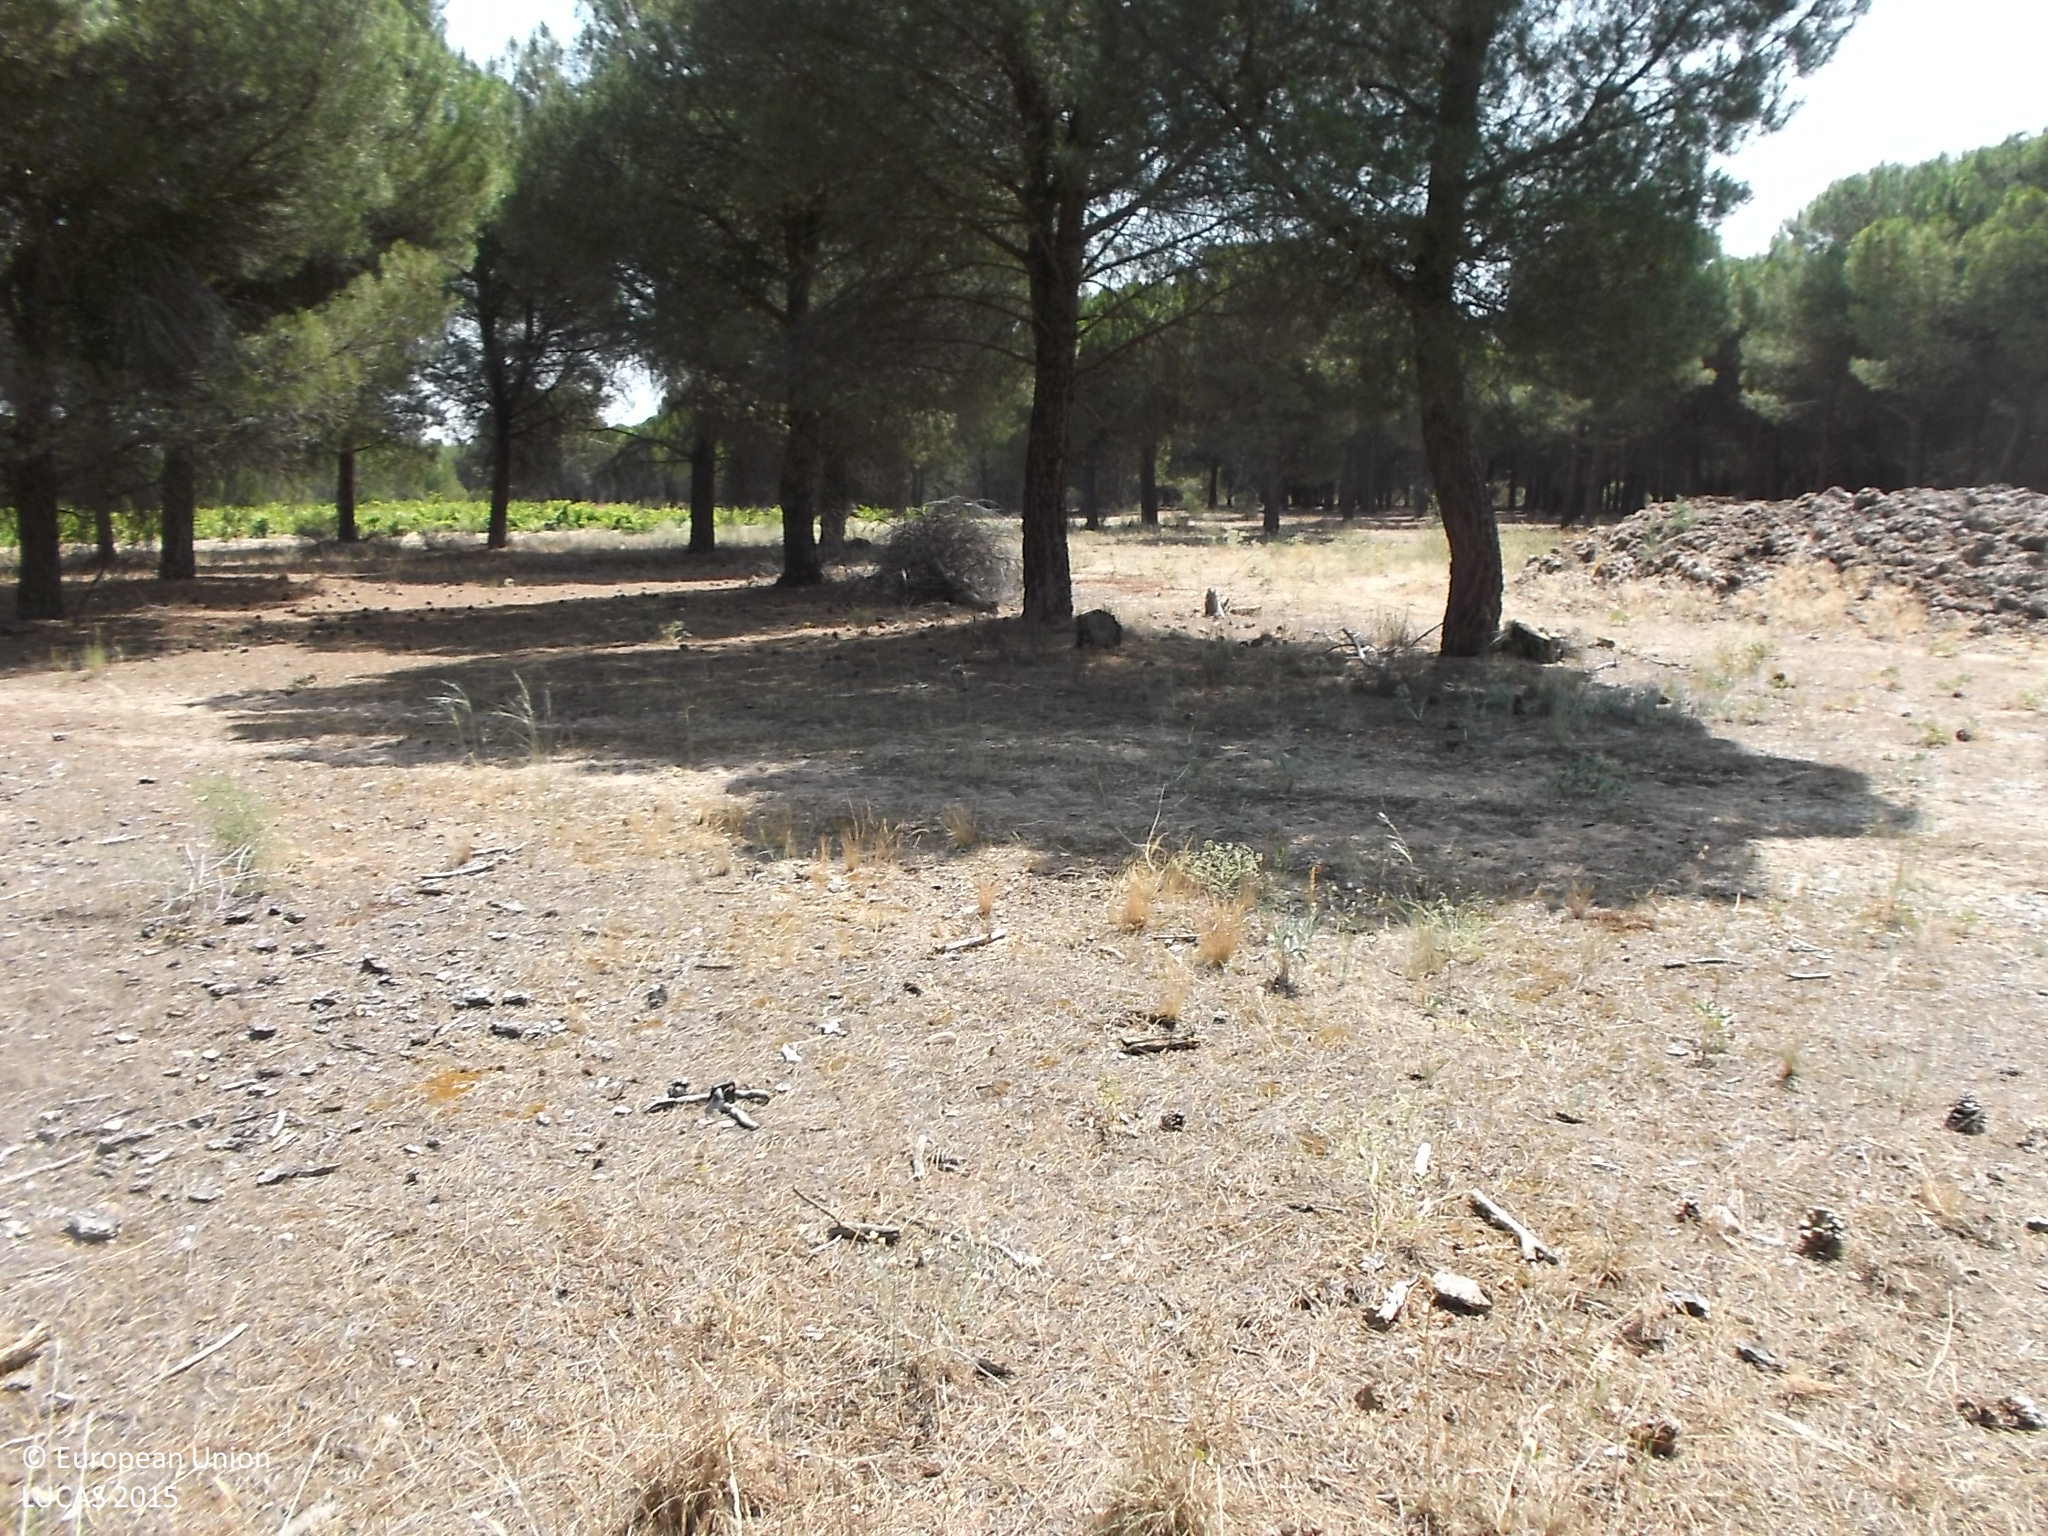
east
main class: Woodland
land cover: Pine dominated coniferous woodland
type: coniferous forest of the mediterranean region
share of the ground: > 75 %
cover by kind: coniferous forest trees 90 %, herbaceous plants 10 %
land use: Forestry
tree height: < 5 m
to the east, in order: Pine dominated coniferous woodland; Other bare soil; Pine dominated coniferous woodland
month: July
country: ES
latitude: 41.4691
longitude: -5.3935
